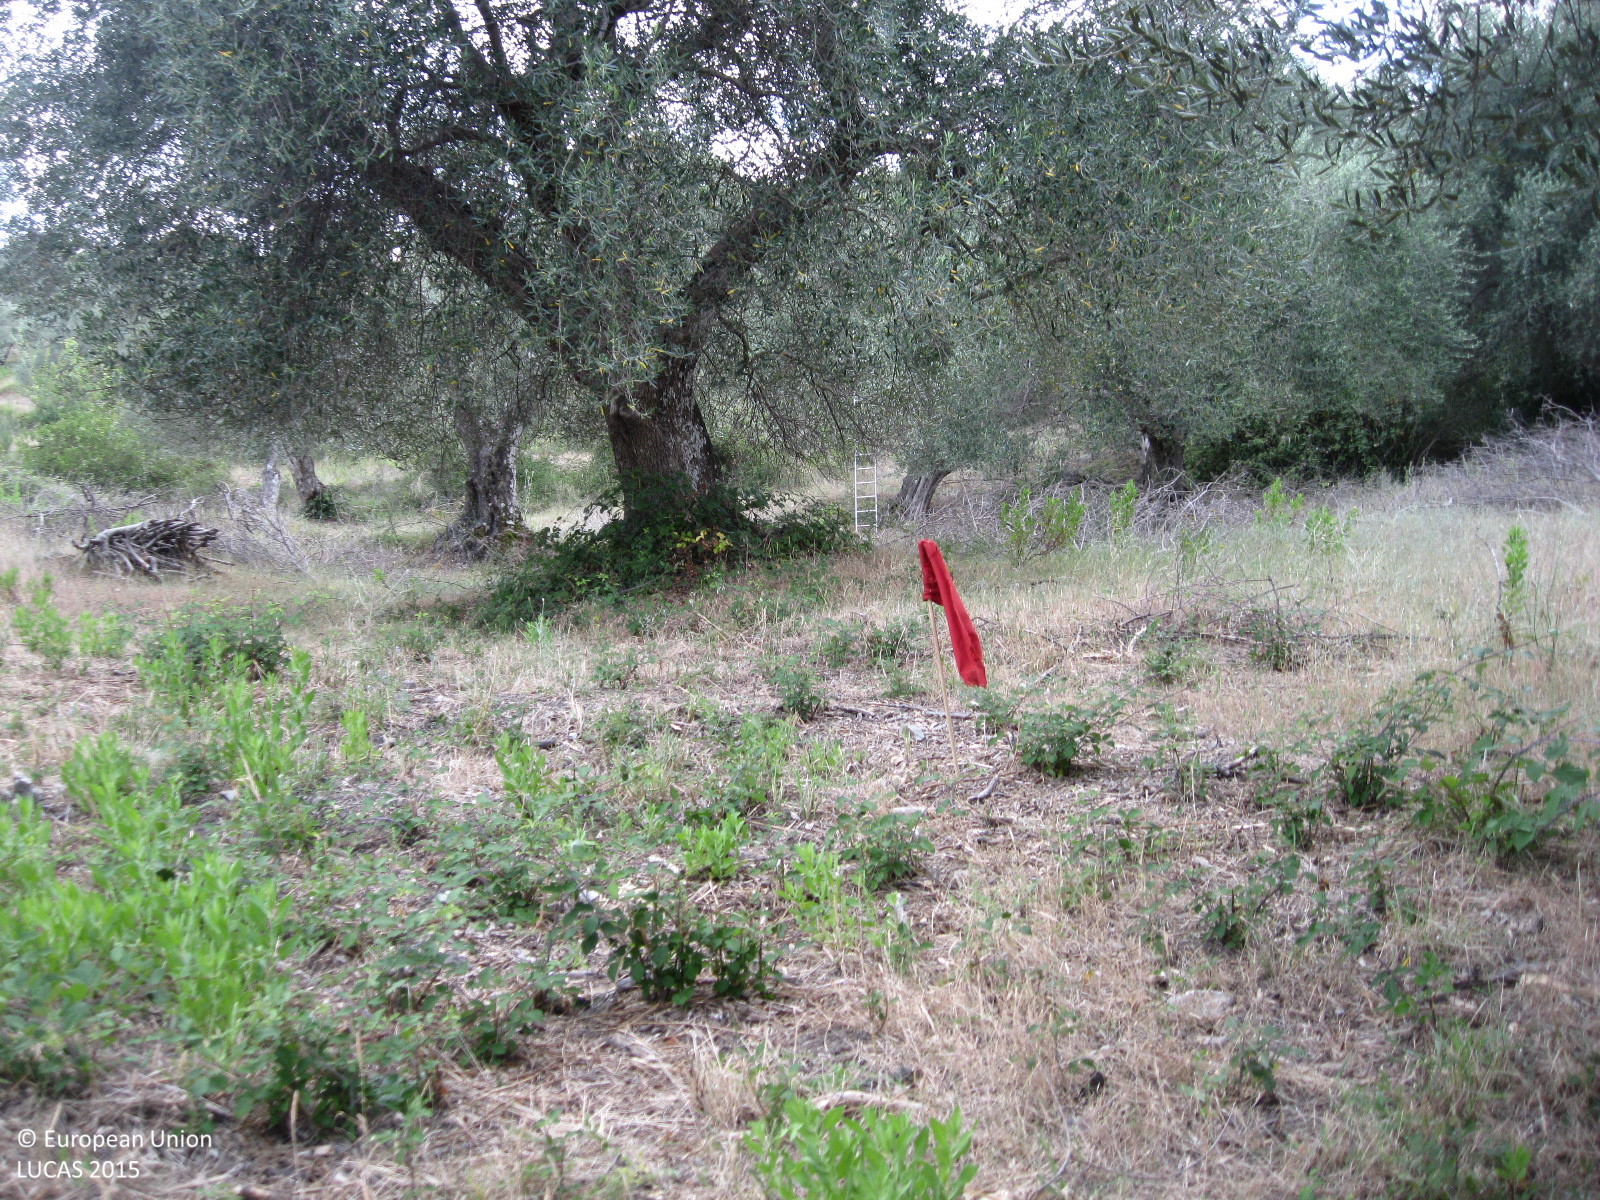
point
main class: Cropland
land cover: Olive groves
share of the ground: > 75 %
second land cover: Grassland without tree/shrub cover
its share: 50 - 75 %
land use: Agriculture (excluding fallow land and kitchen gardens)
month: July
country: IT
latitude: 42.6979
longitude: 11.4479
